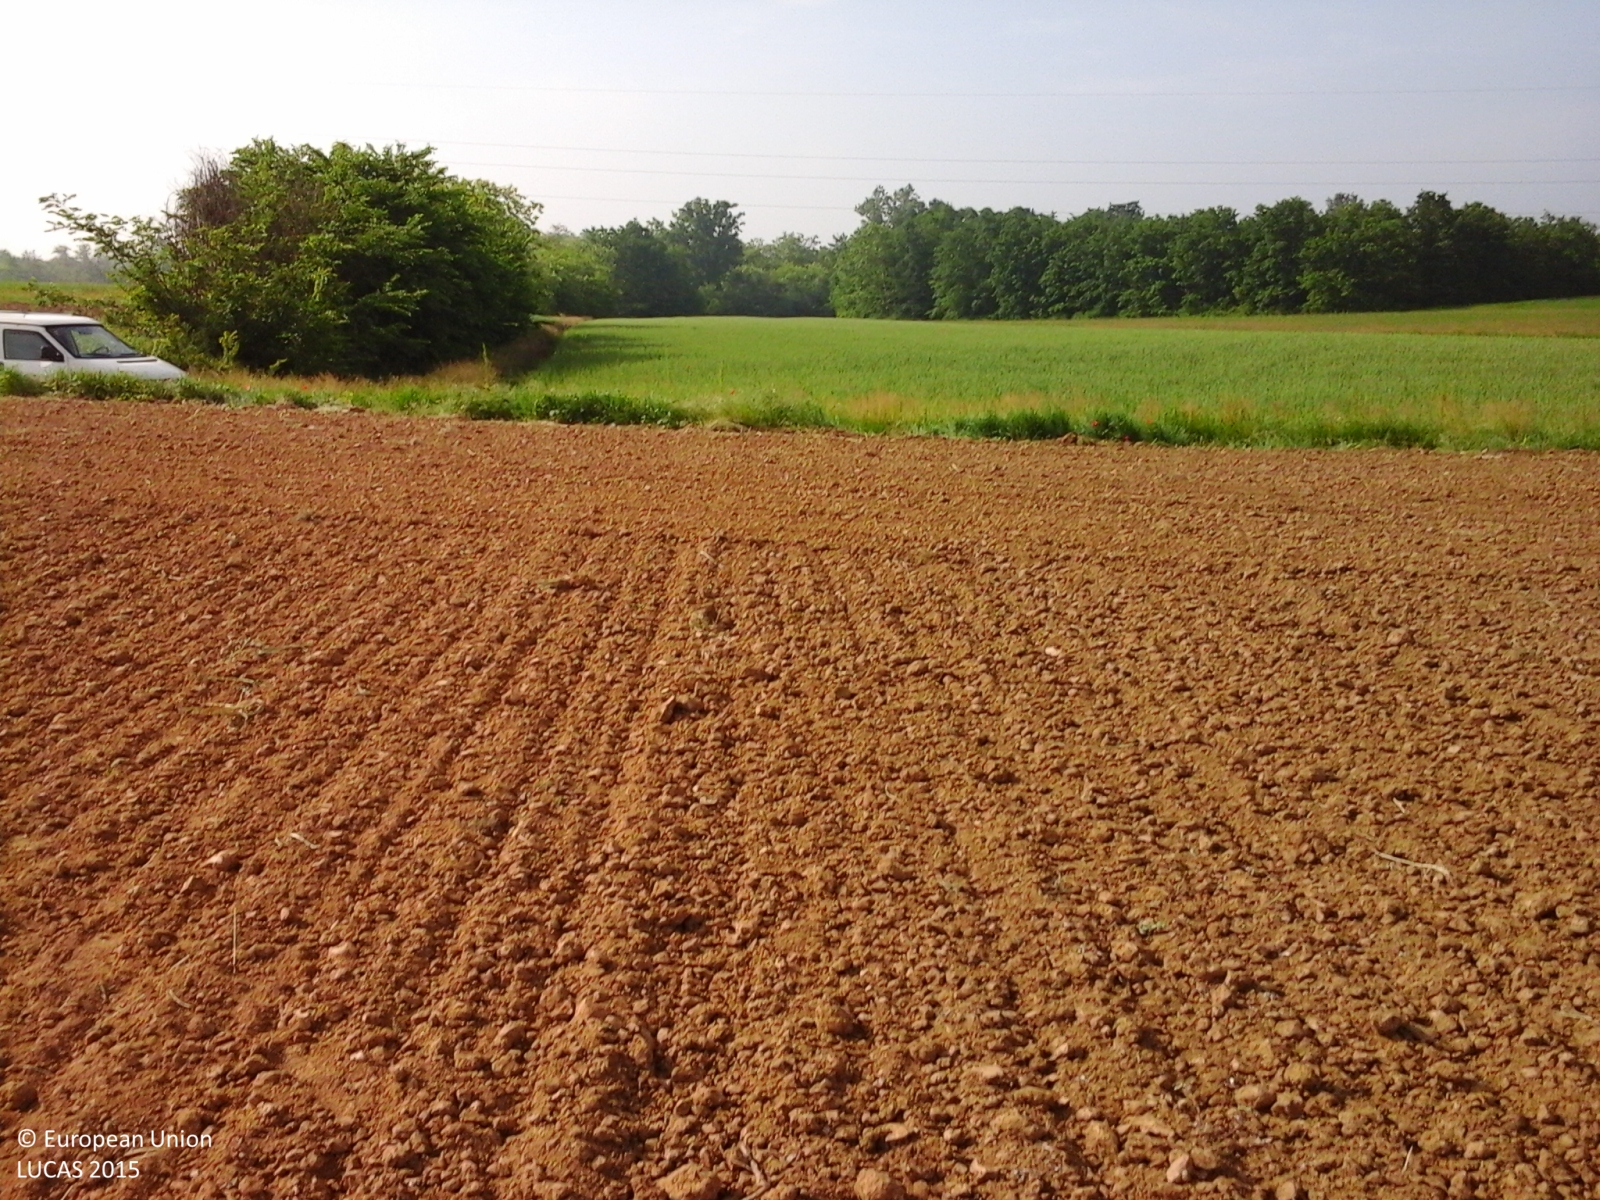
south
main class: Cropland
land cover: Other fibre and oleaginous crops
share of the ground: < 10 %
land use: Agriculture (excluding fallow land and kitchen gardens)
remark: Tilled/Sowed
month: May
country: IT
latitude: 44.9157
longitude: 8.4196
